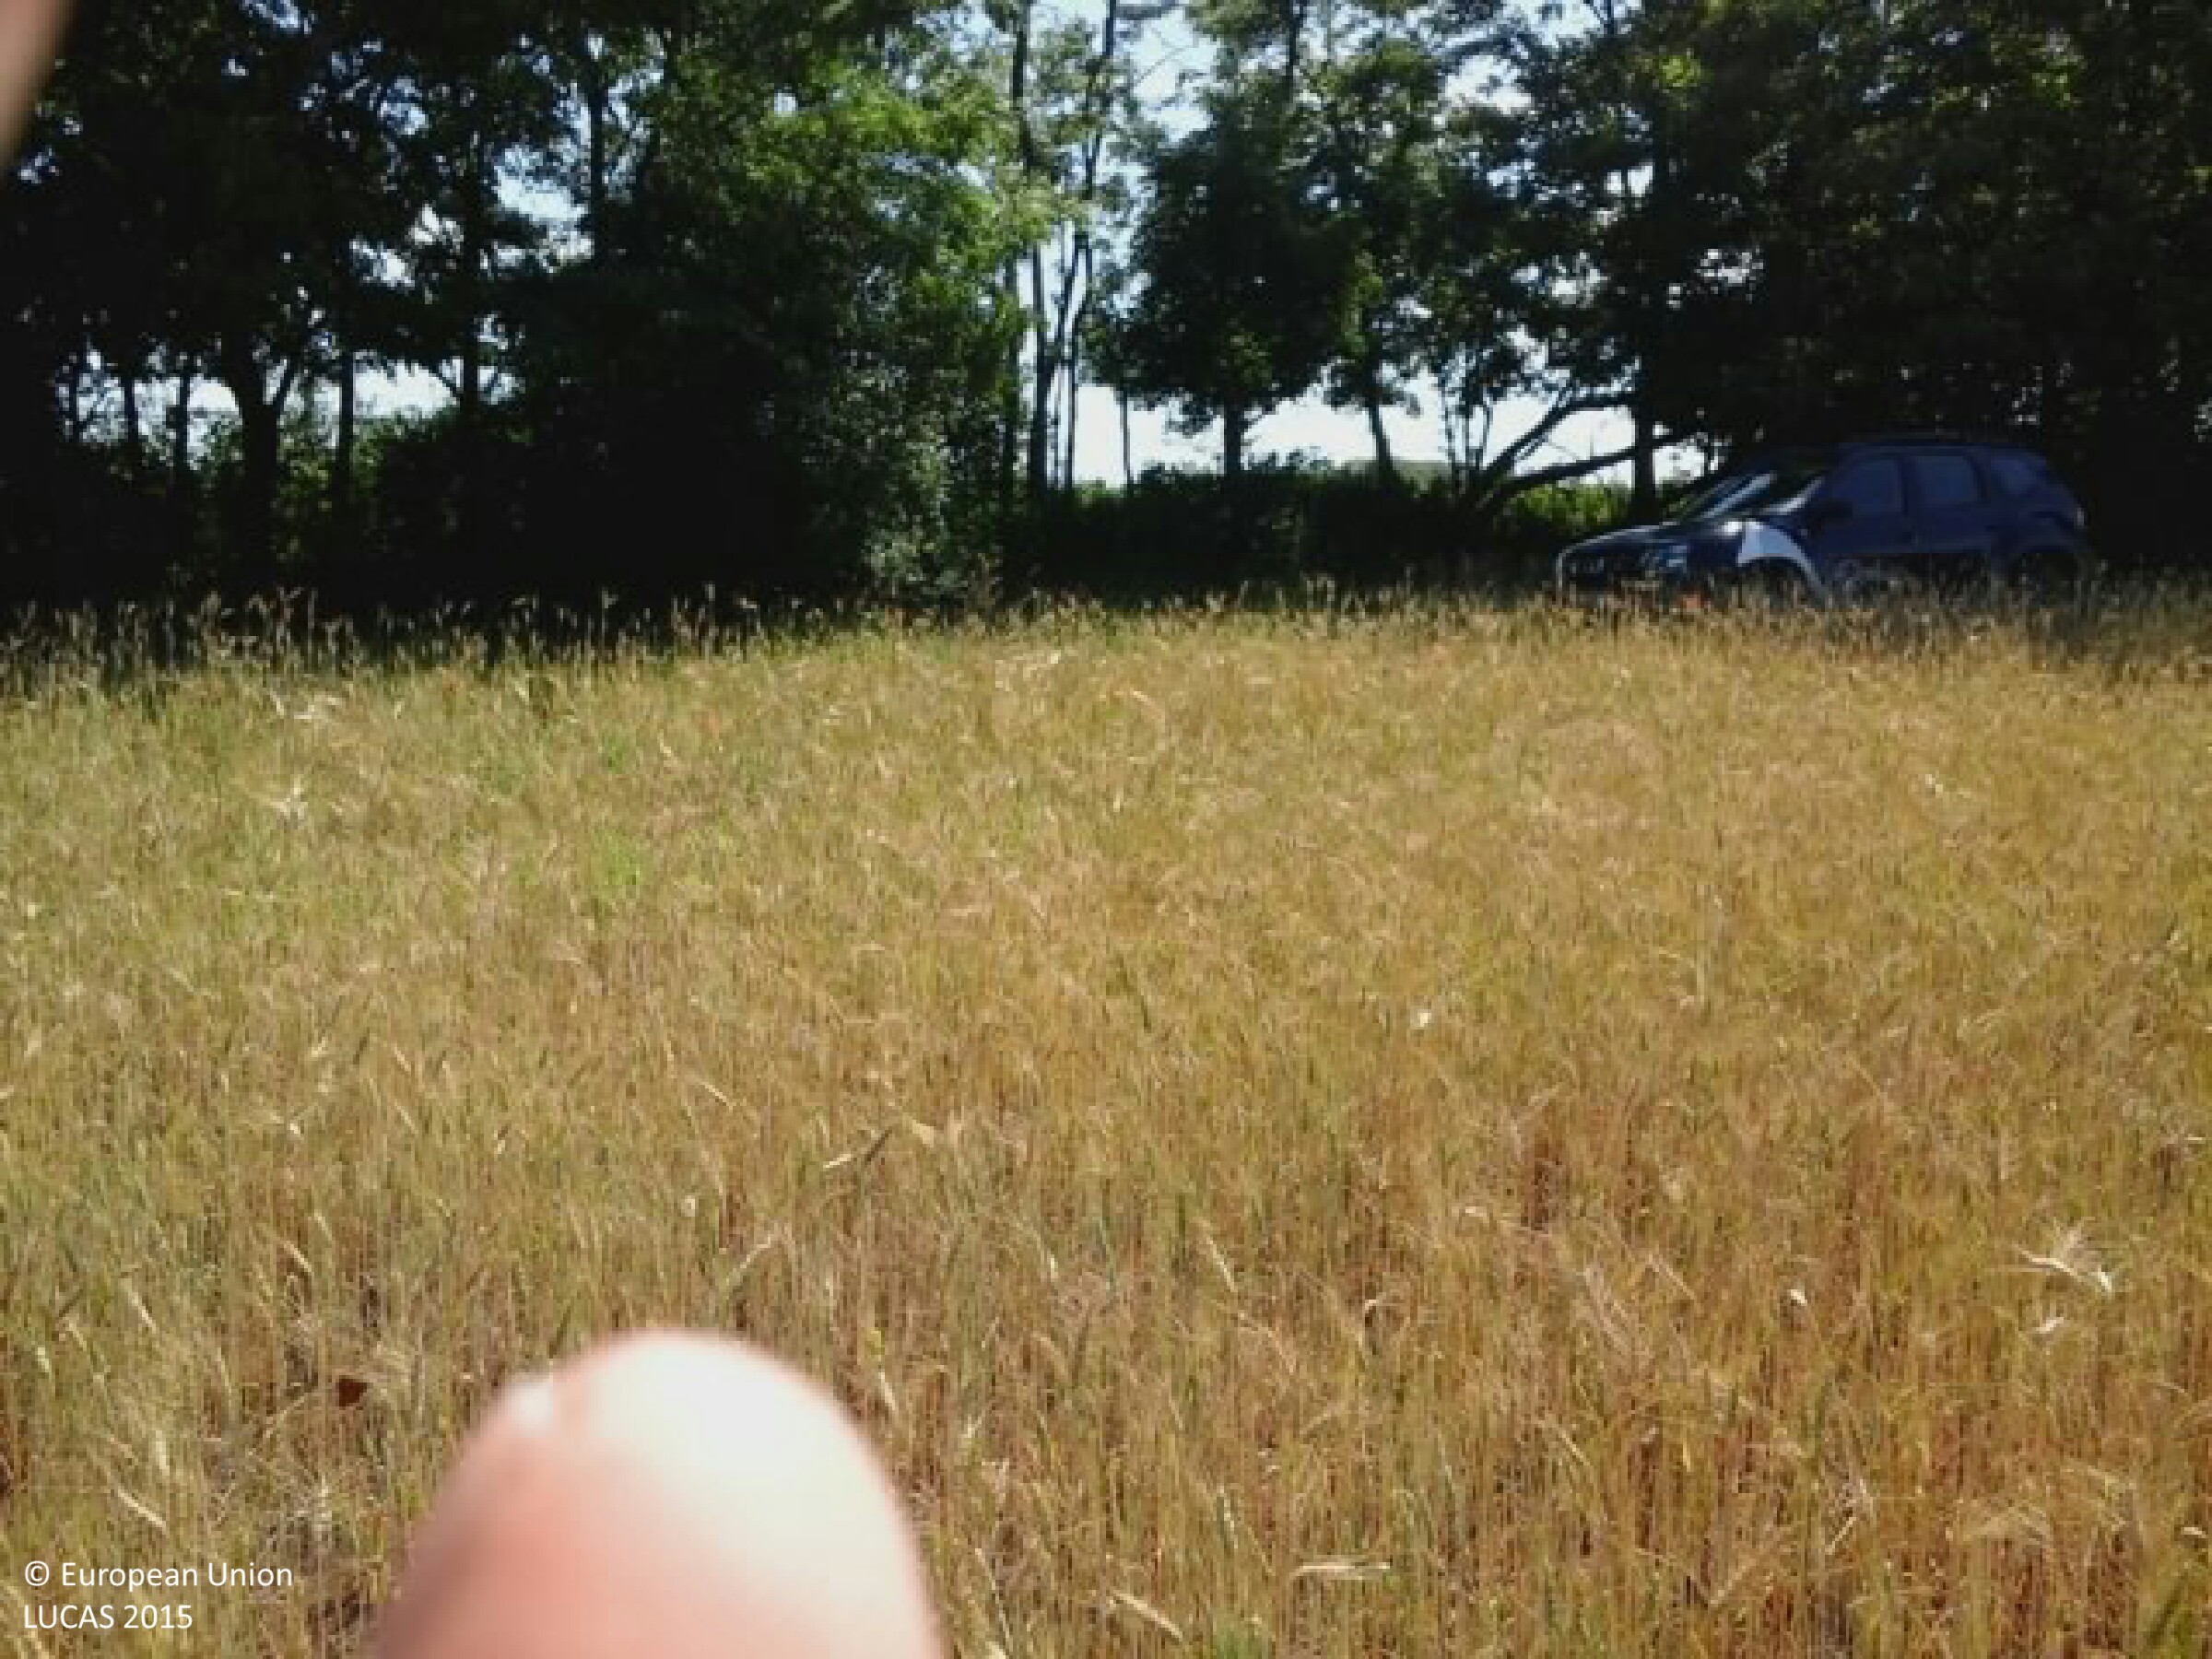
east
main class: Cropland
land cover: Common wheat
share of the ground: > 75 %
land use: Agriculture (excluding fallow land and kitchen gardens)
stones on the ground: < 10 %
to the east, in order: Common wheat; Grass margins; Broadleaved woodland; Ditches and canals; Broadleaved woodland; Grass margins; Common wheat
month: June
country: HU
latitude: 46.3525
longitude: 19.2021
